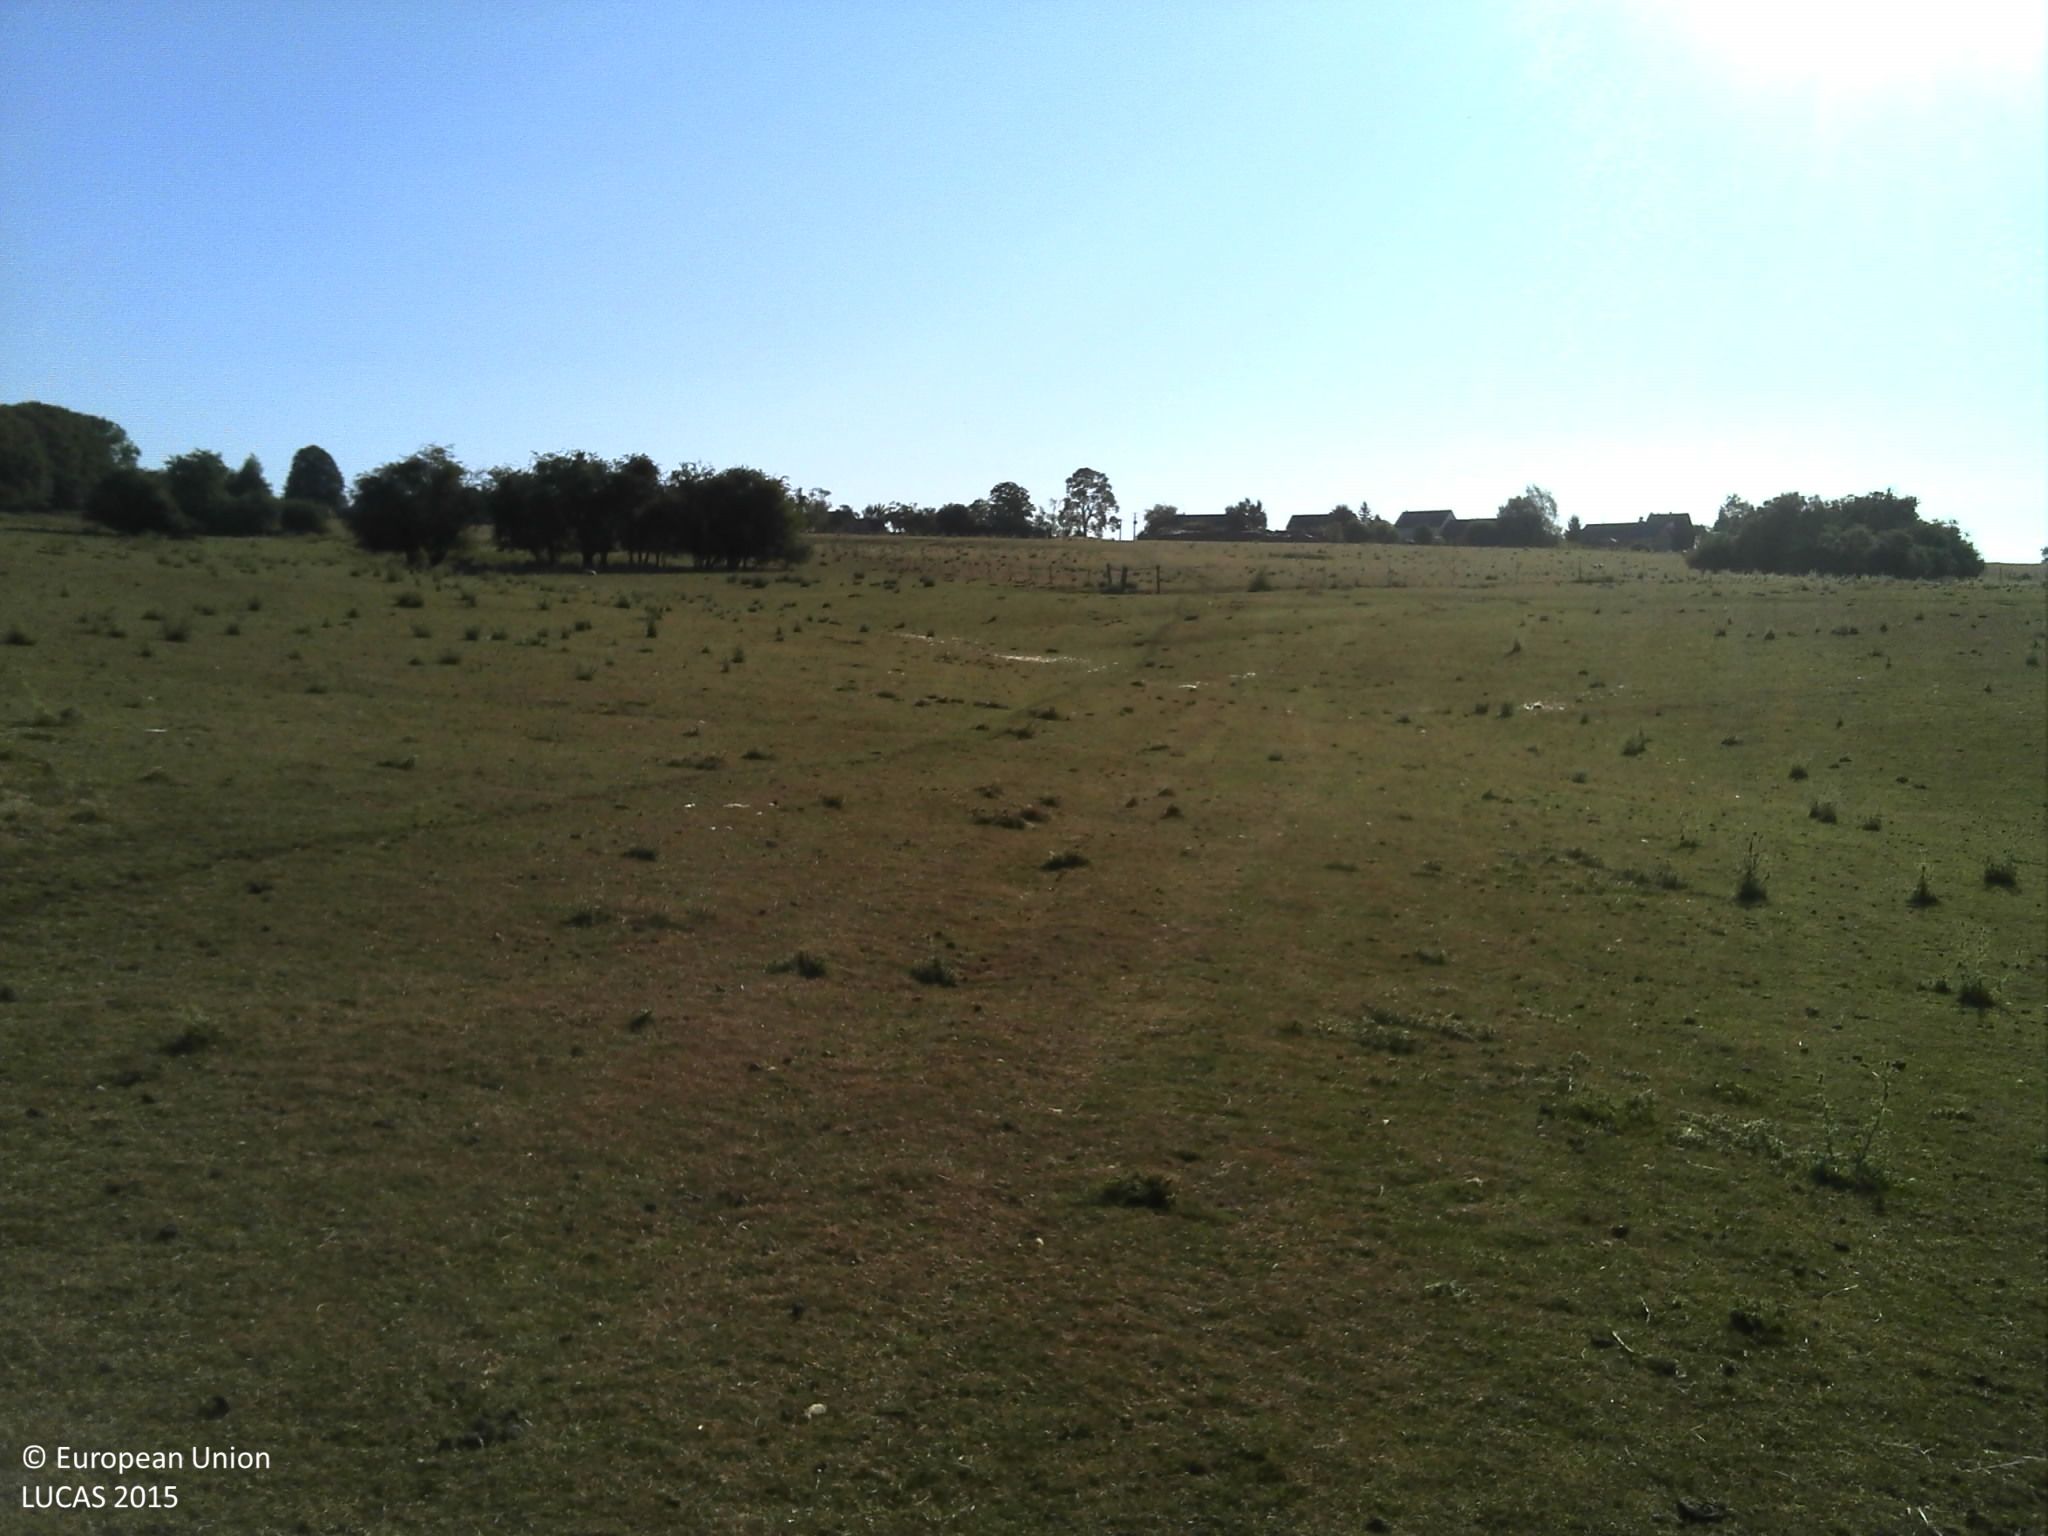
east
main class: Grassland
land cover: Grassland without tree/shrub cover
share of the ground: > 75 %
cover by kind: herbaceous plants 100 %
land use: Agriculture (excluding fallow land and kitchen gardens)
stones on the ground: < 10 %
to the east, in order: Grassland without tree/shrub cover; Fences; Grassland without tree/shrub cover
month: July
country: FR
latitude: 49.6295
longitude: 4.7220
